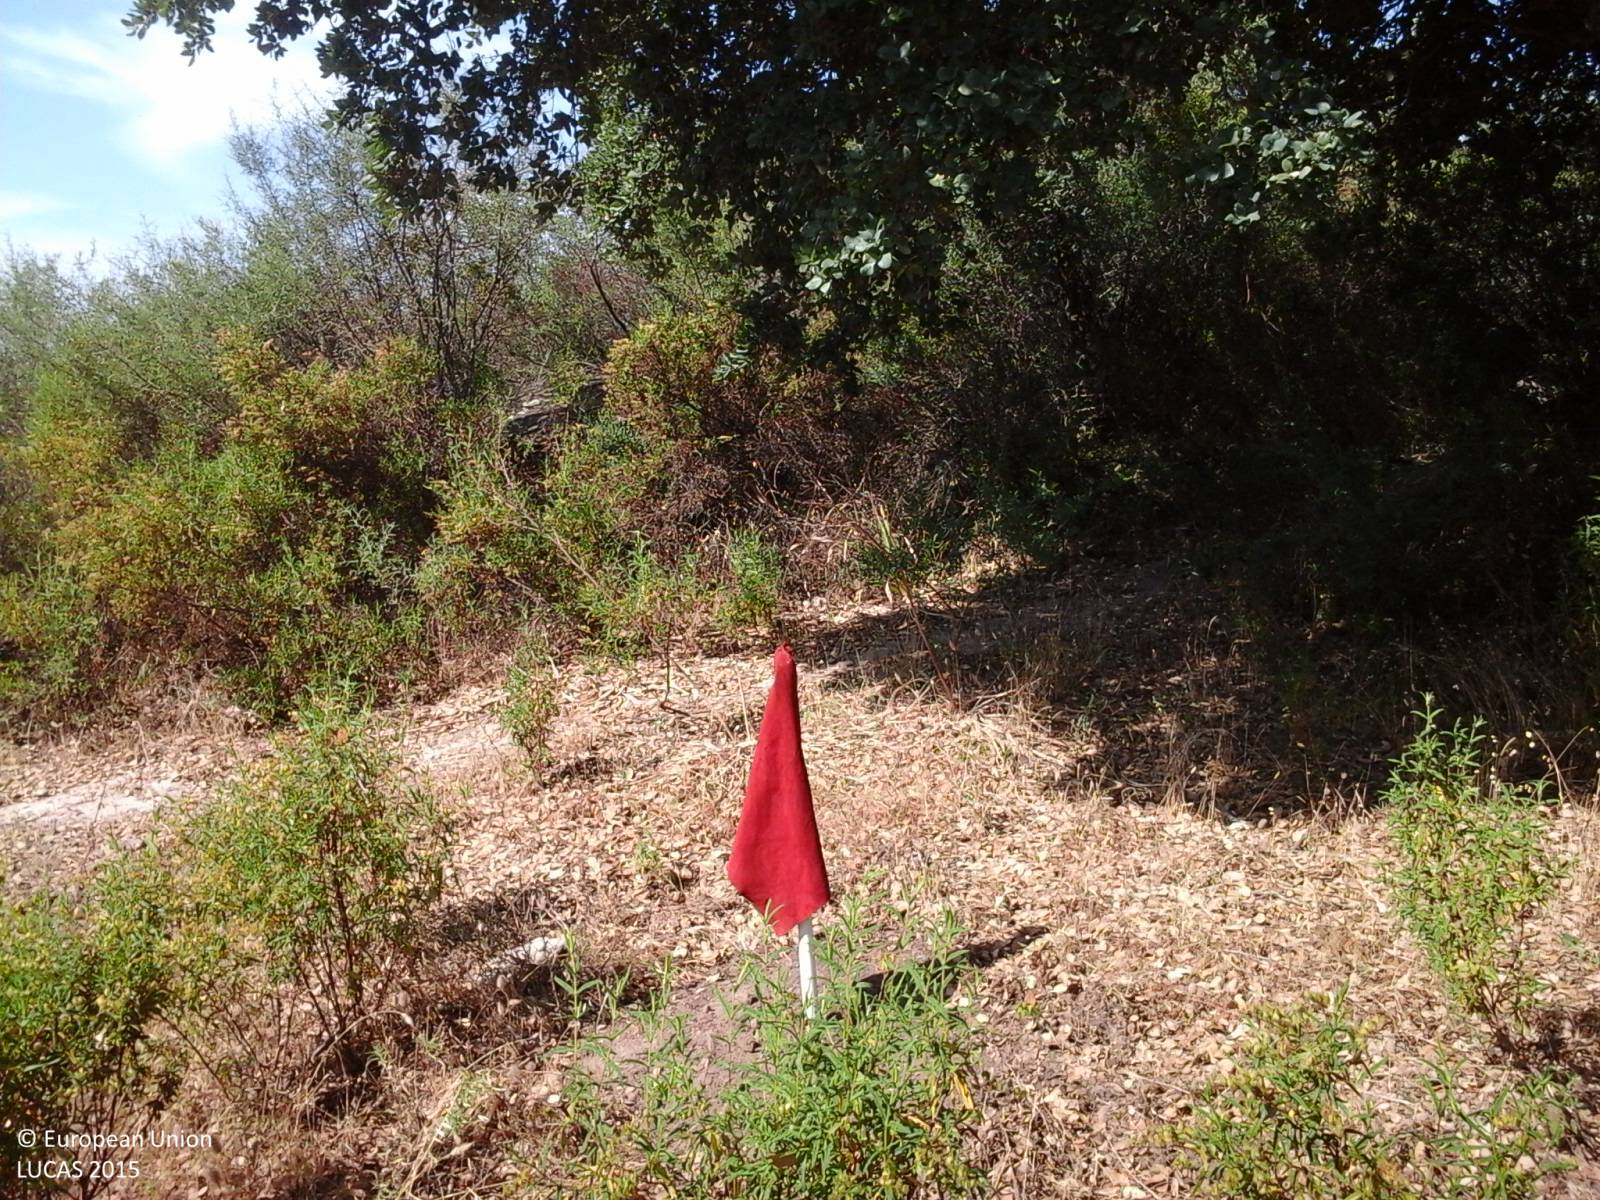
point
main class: Woodland
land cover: Broadleaved woodland
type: broadleaved evergreen forest
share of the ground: 25 - 50 %
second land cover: Grassland without tree/shrub cover
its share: 50 - 75 %
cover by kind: herbaceous plants 45 %, broadleaved forest trees 30 %, shrubs 25 %
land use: Forestry
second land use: Agriculture (excluding fallow land and kitchen gardens)
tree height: > 5 m
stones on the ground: < 10 %
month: June
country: IT
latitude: 40.5814
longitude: 8.4835
